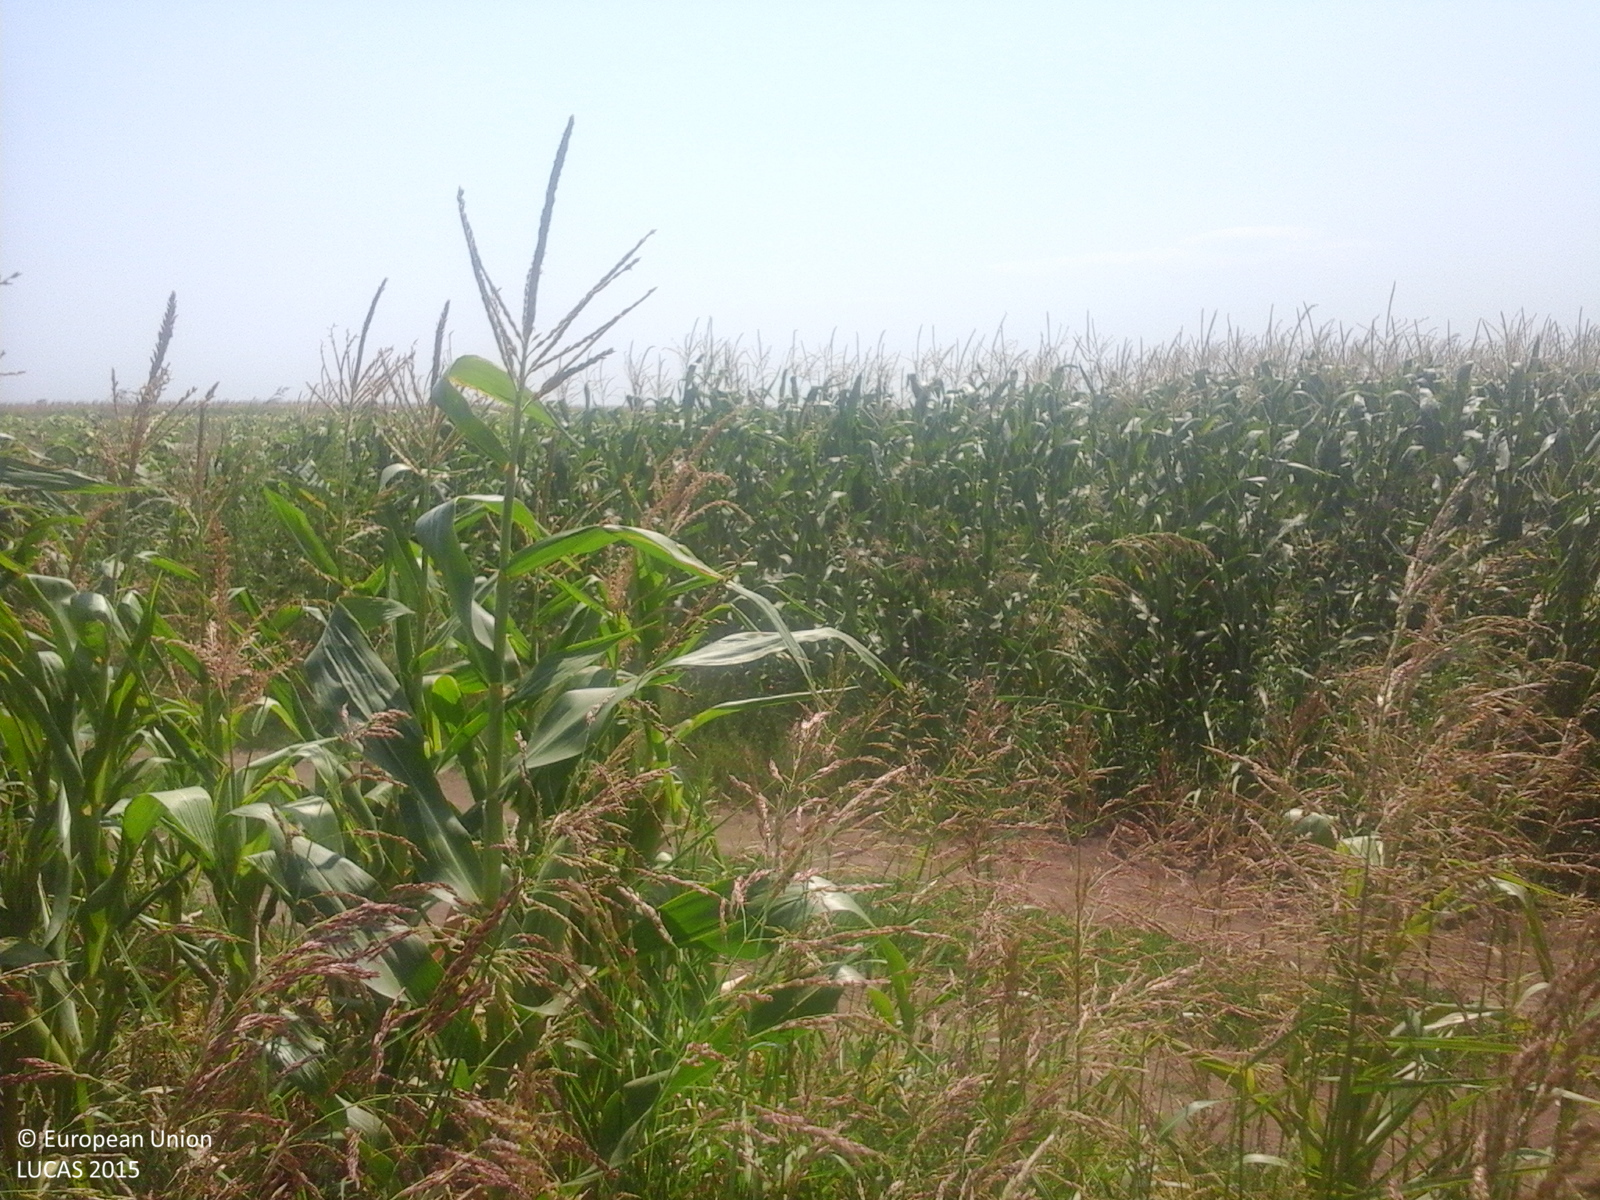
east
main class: Cropland
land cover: Maize
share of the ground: > 75 %
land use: Agriculture (excluding fallow land and kitchen gardens)
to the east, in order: Maize; Spontaneously vegetated surfaces; Maize
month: August
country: RO
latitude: 45.1814
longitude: 27.7582
